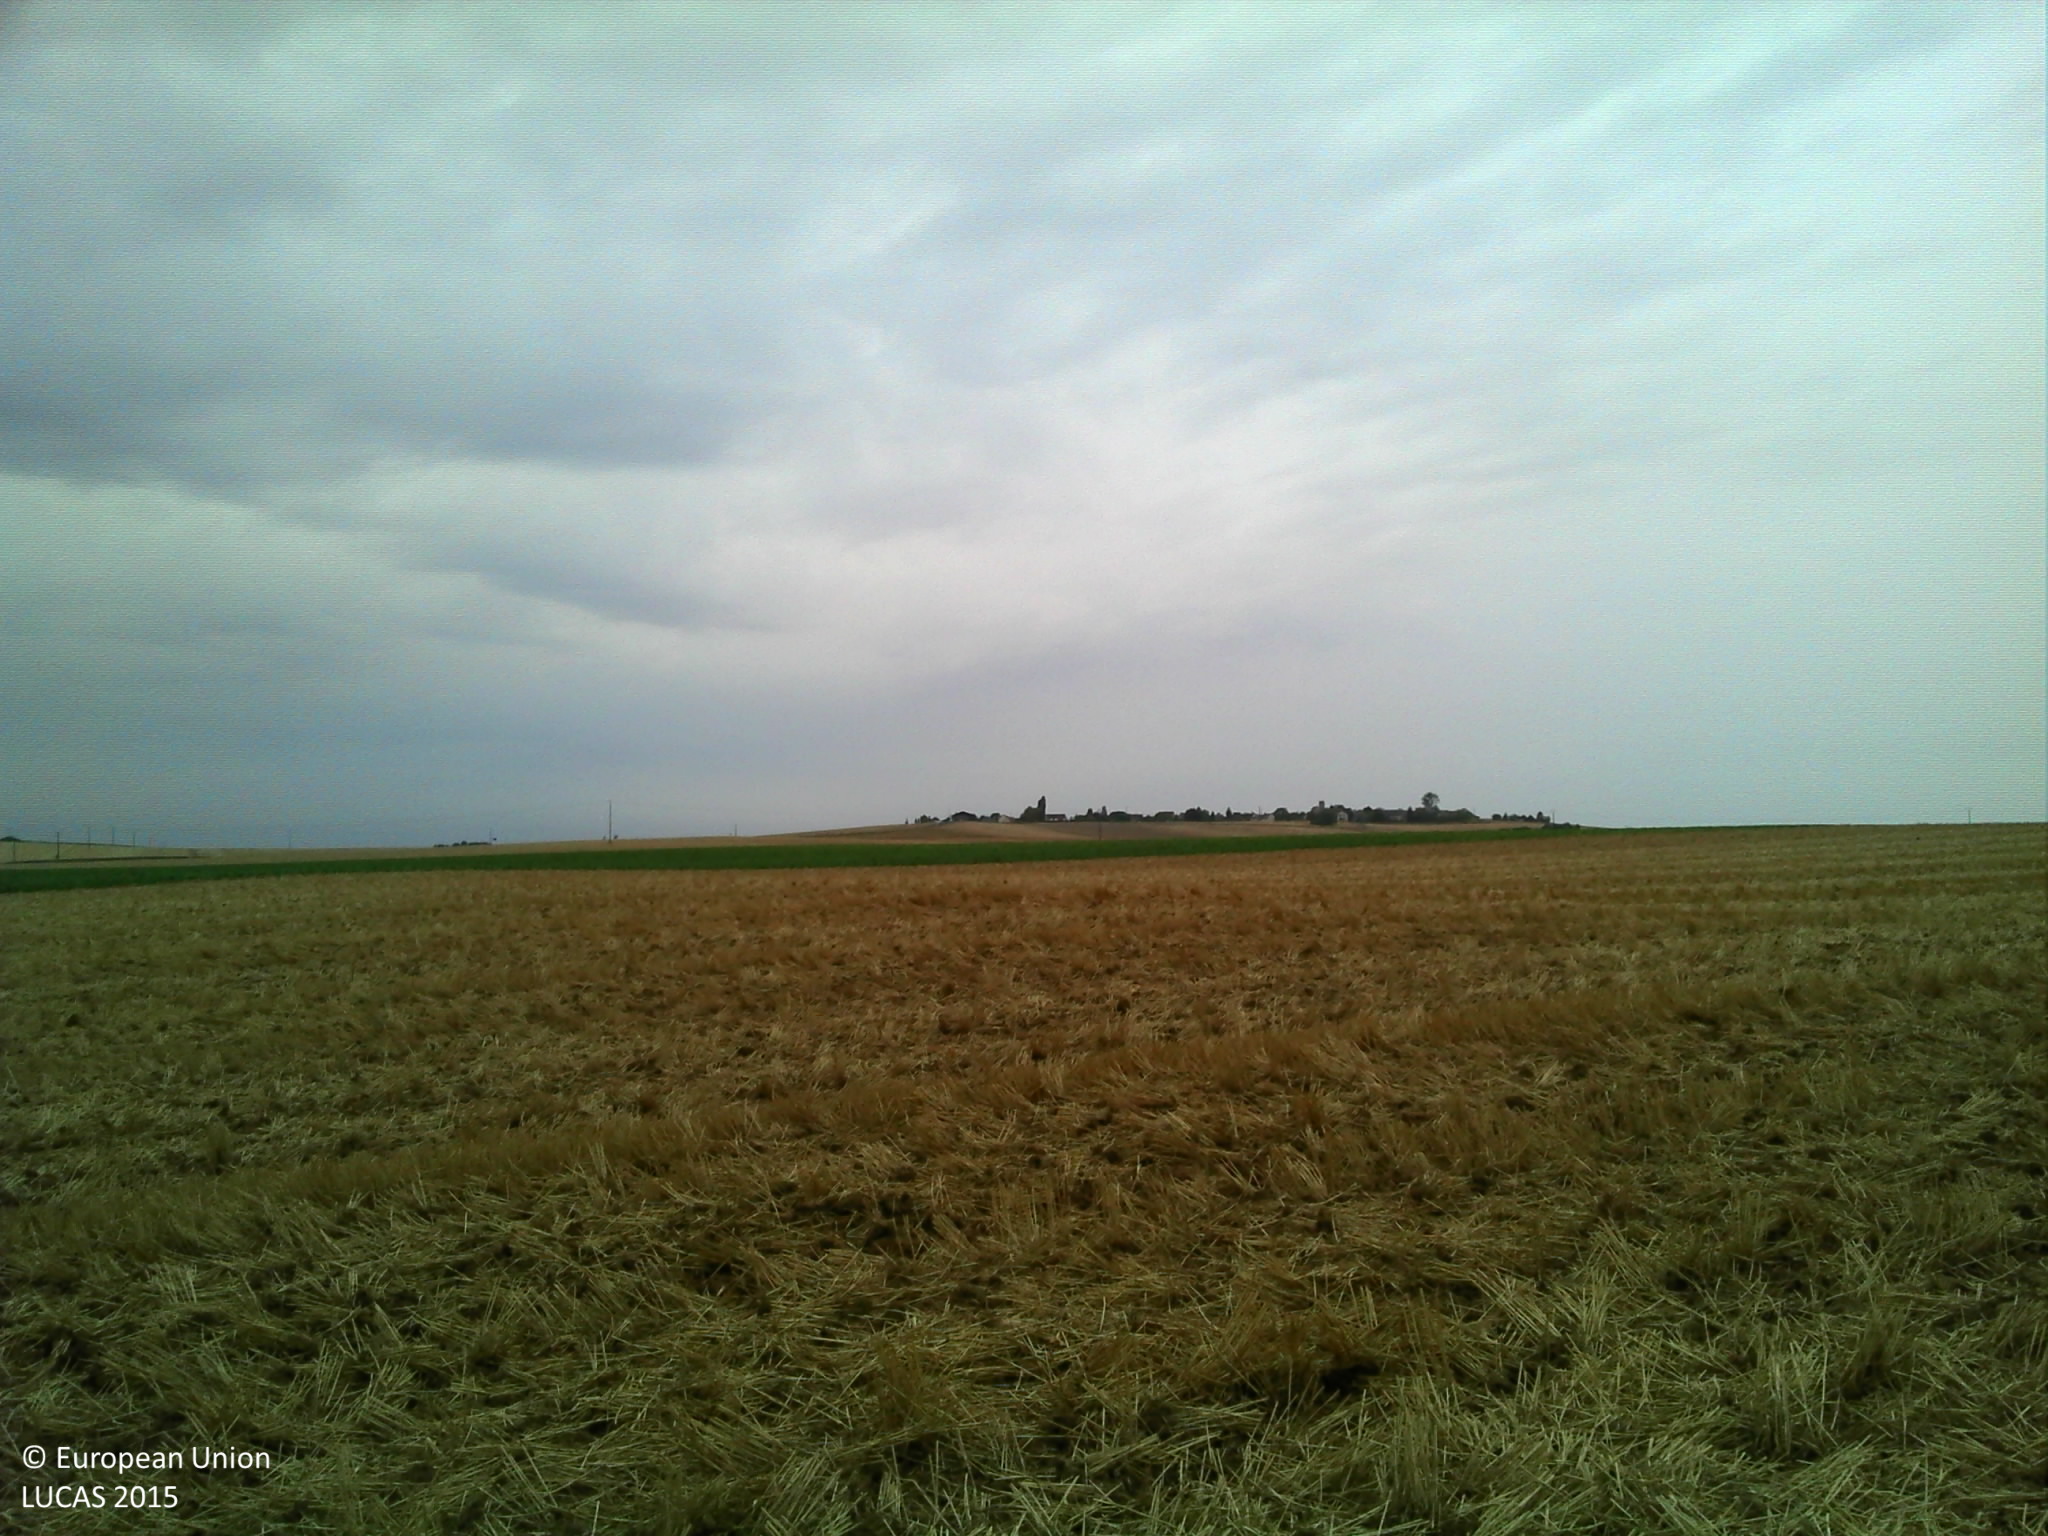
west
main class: Cropland
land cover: Common wheat
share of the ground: 10 - 25 %
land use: Agriculture (excluding fallow land and kitchen gardens)
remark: Harvested field
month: August
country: FR
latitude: 48.2419
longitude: 2.5437
